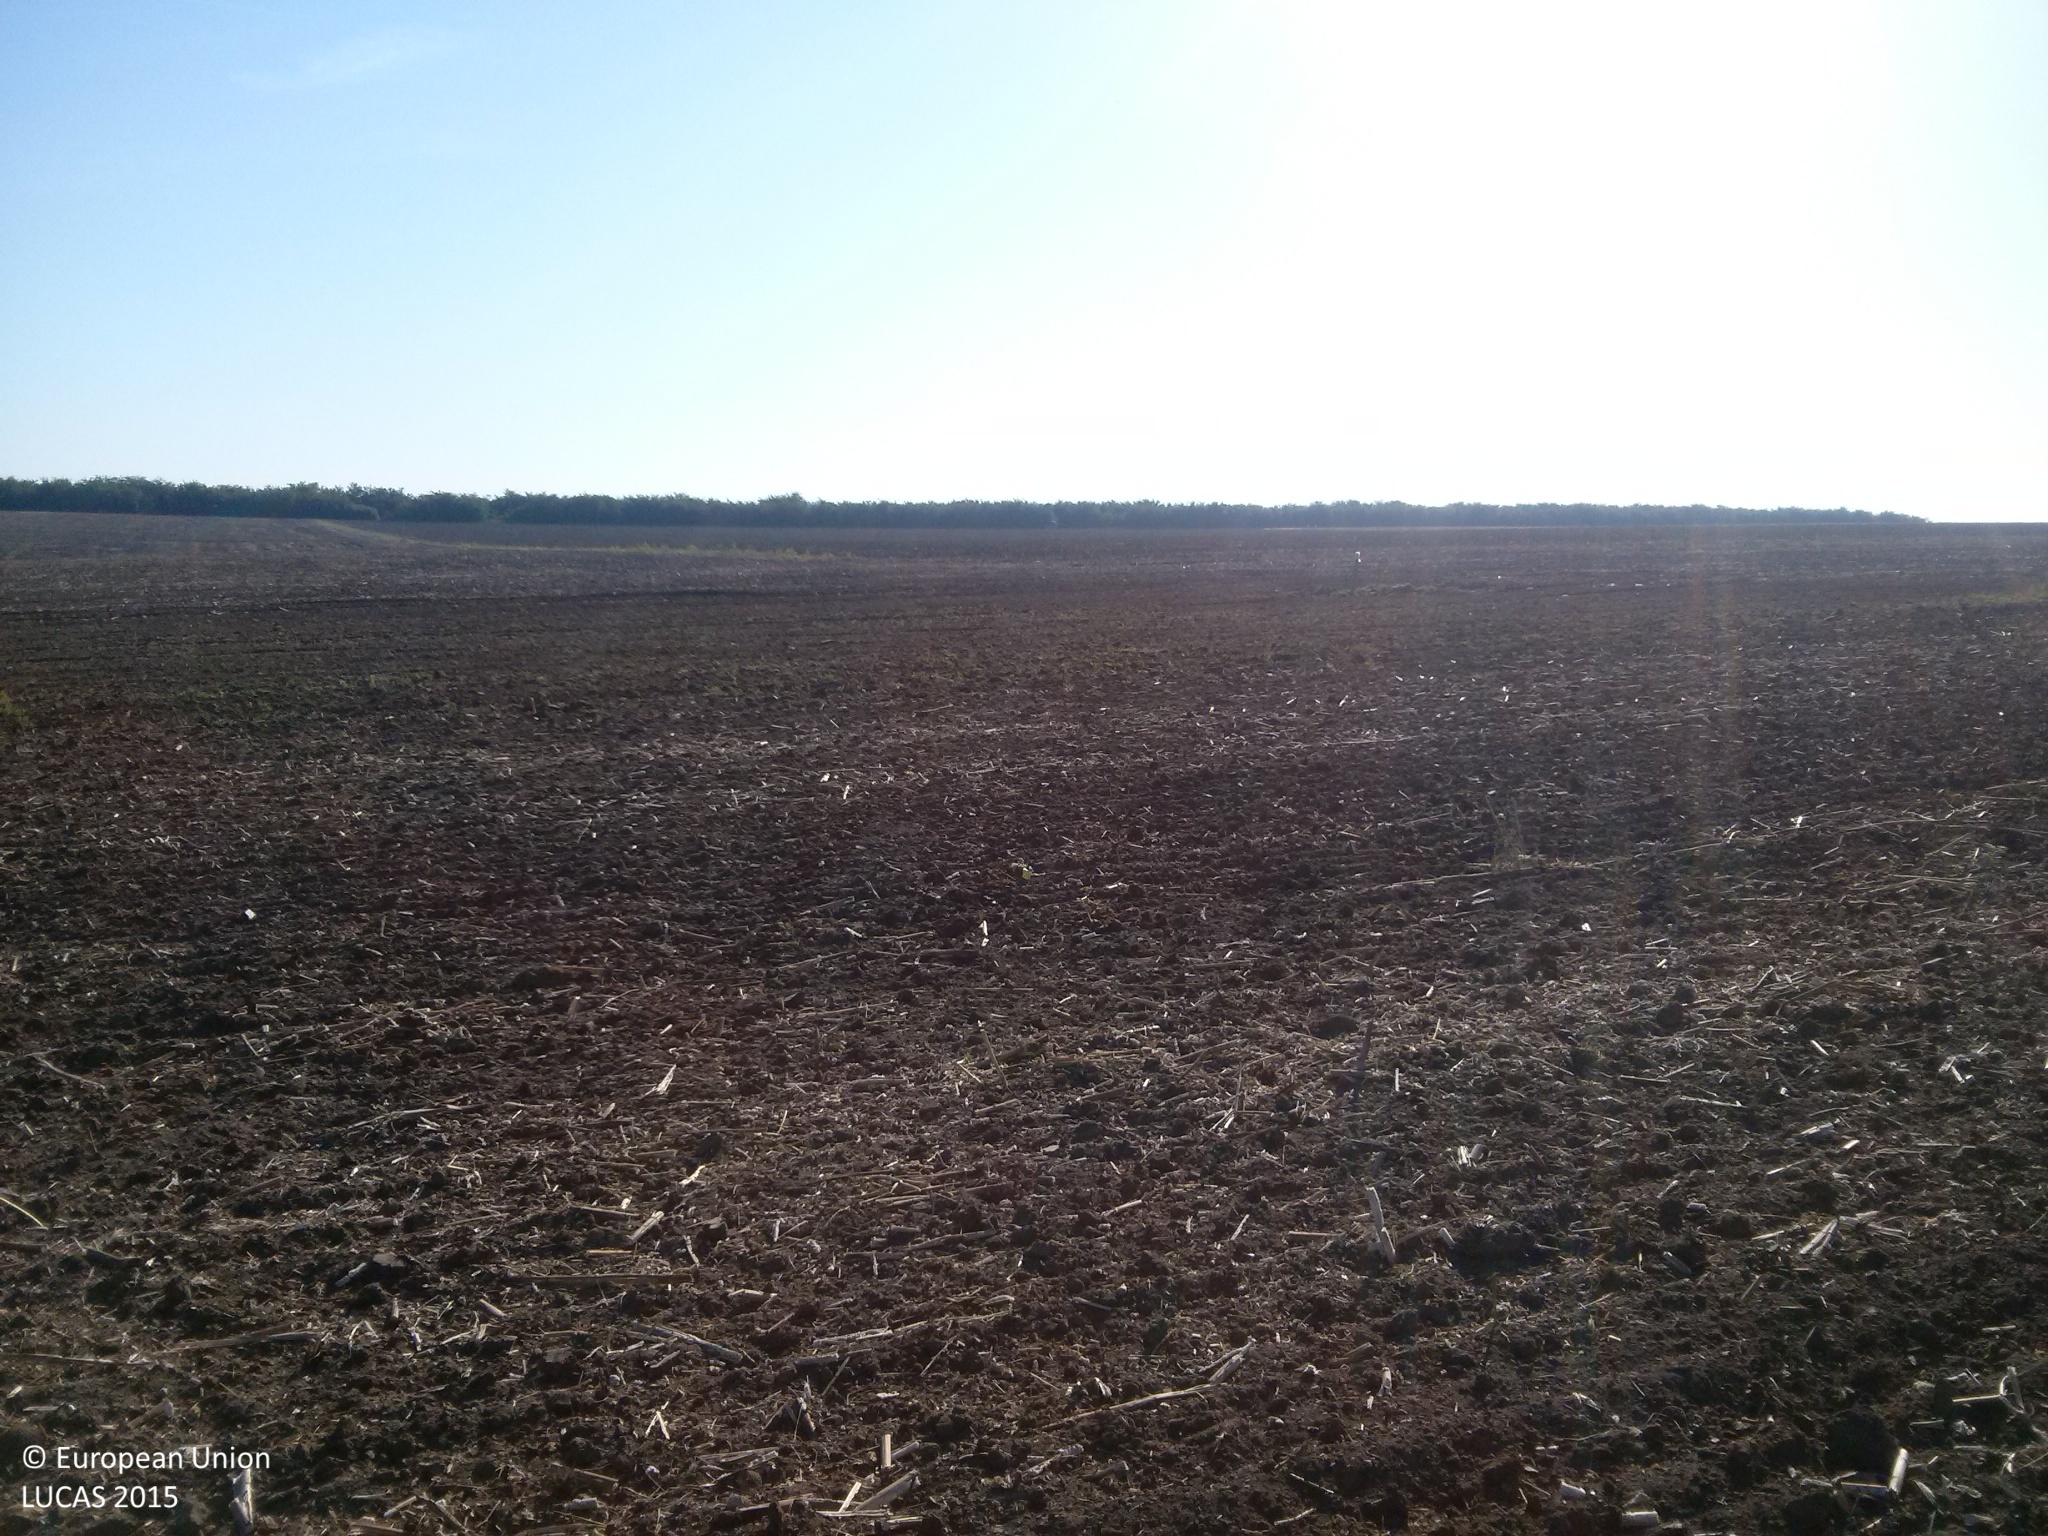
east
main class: Cropland
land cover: Sunflower
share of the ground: < 10 %
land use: Agriculture (excluding fallow land and kitchen gardens)
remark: Harvested field
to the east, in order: Sunflower
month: September
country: BG
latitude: 43.7459
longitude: 26.4355
